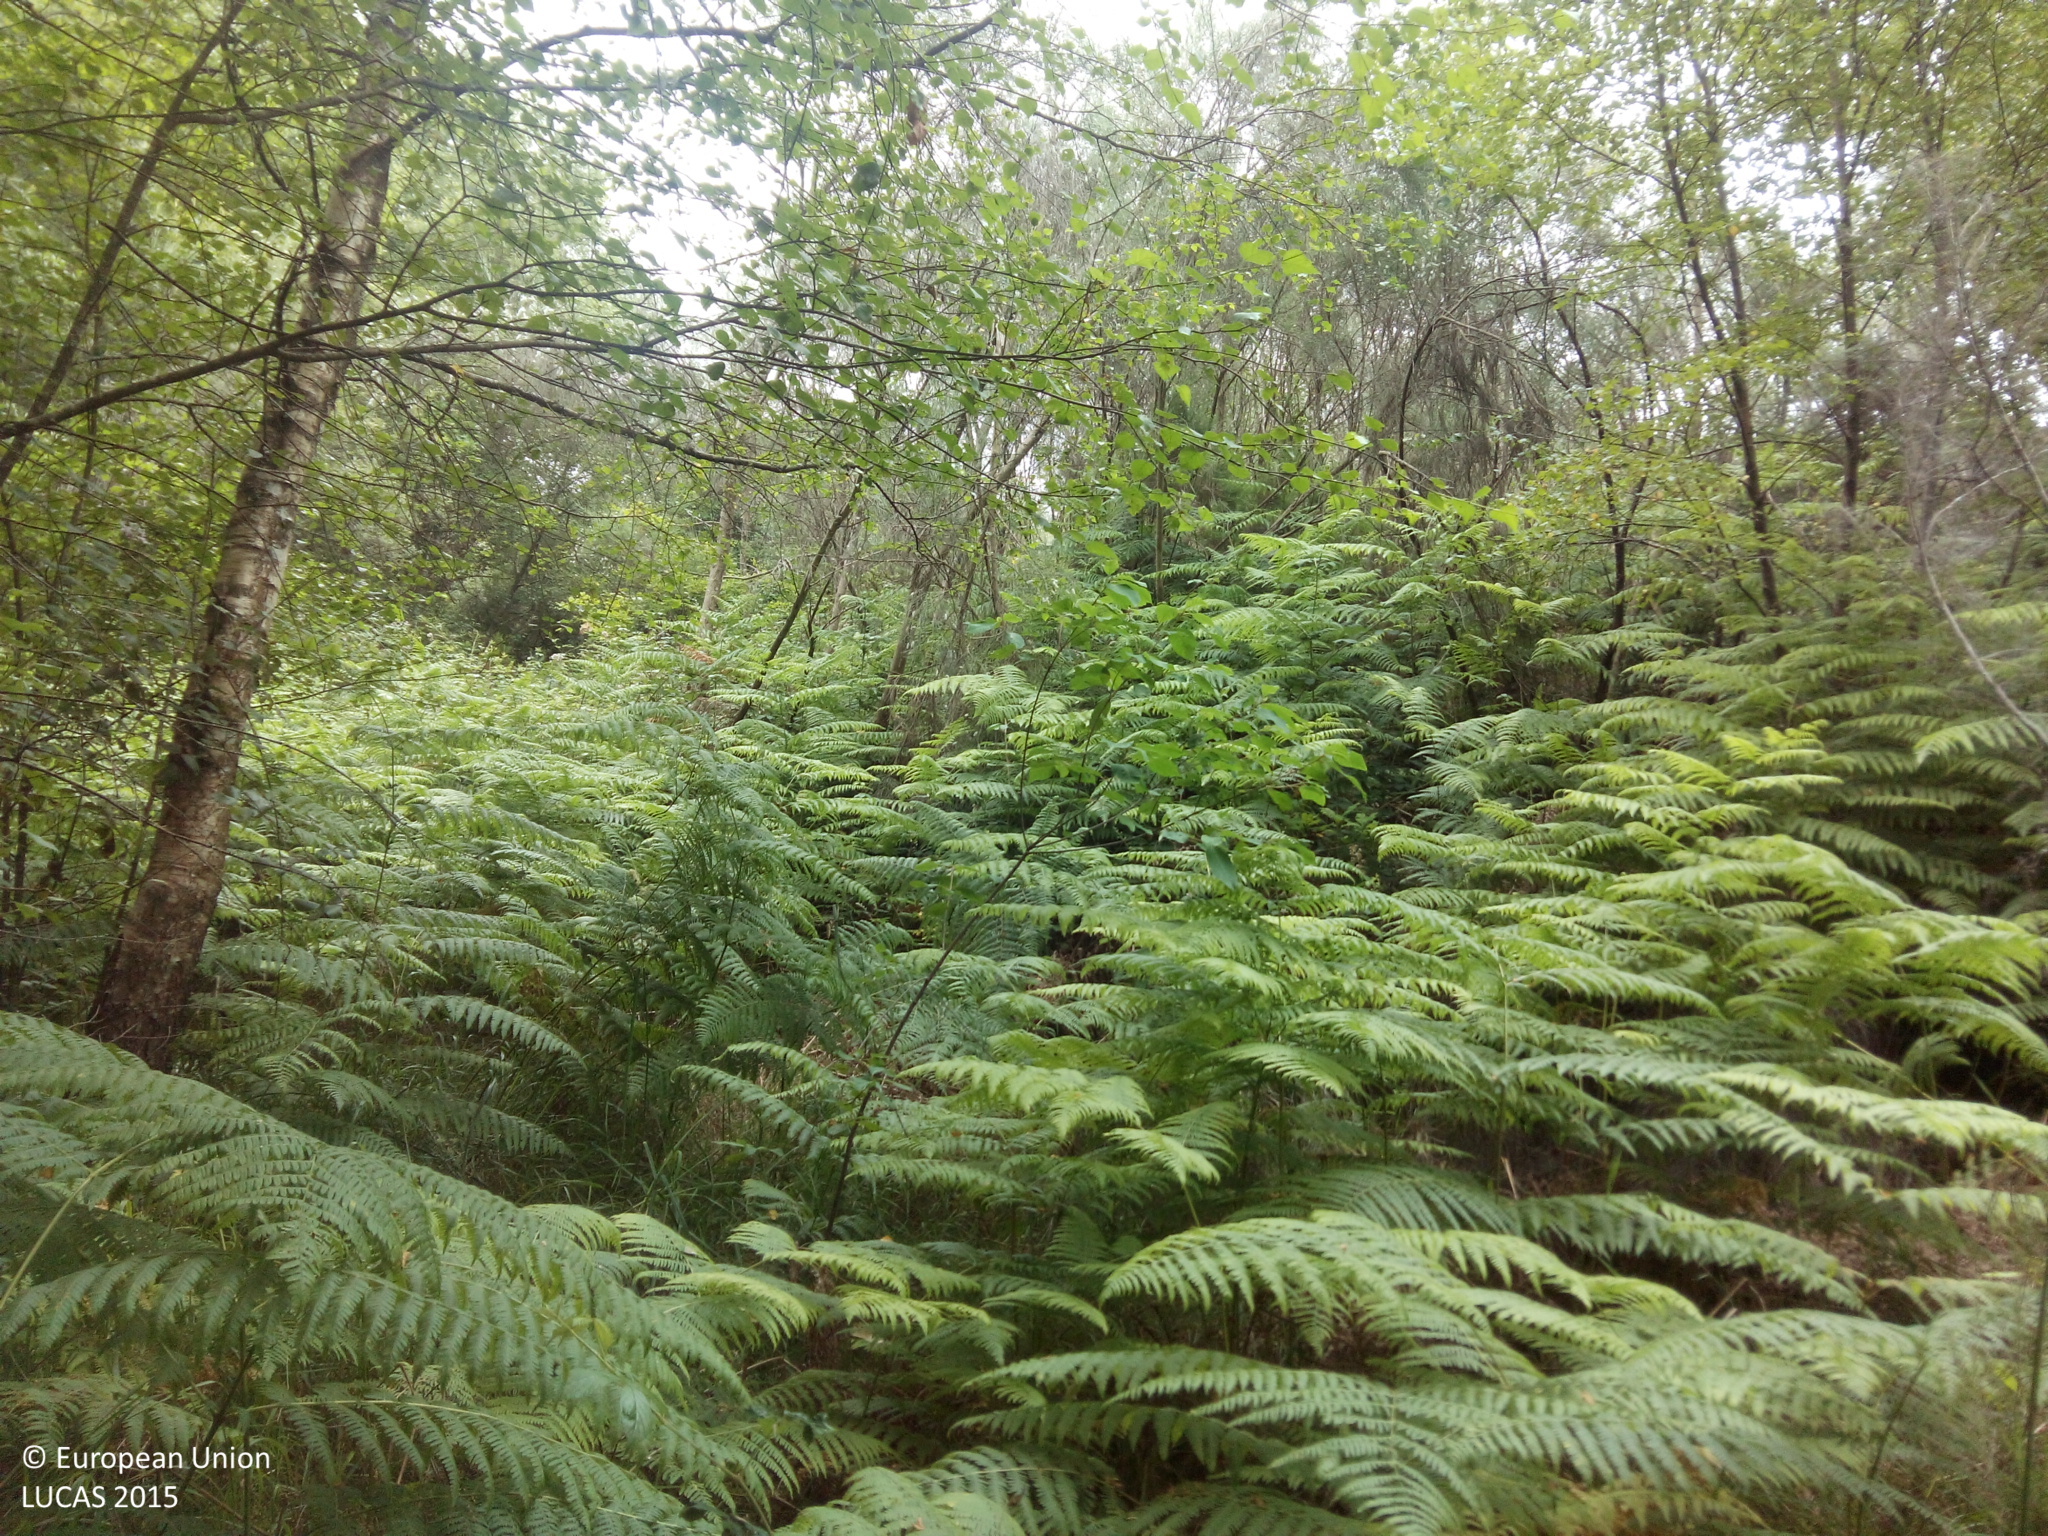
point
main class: Shrubland
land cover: Shrubland without tree cover
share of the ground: 10 - 25 %
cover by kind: consolidated bare surface 80 %, shrubs 20 %
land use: Semi-natural and natural areas not in use
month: July
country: ES
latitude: 42.2742
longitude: -8.2382
